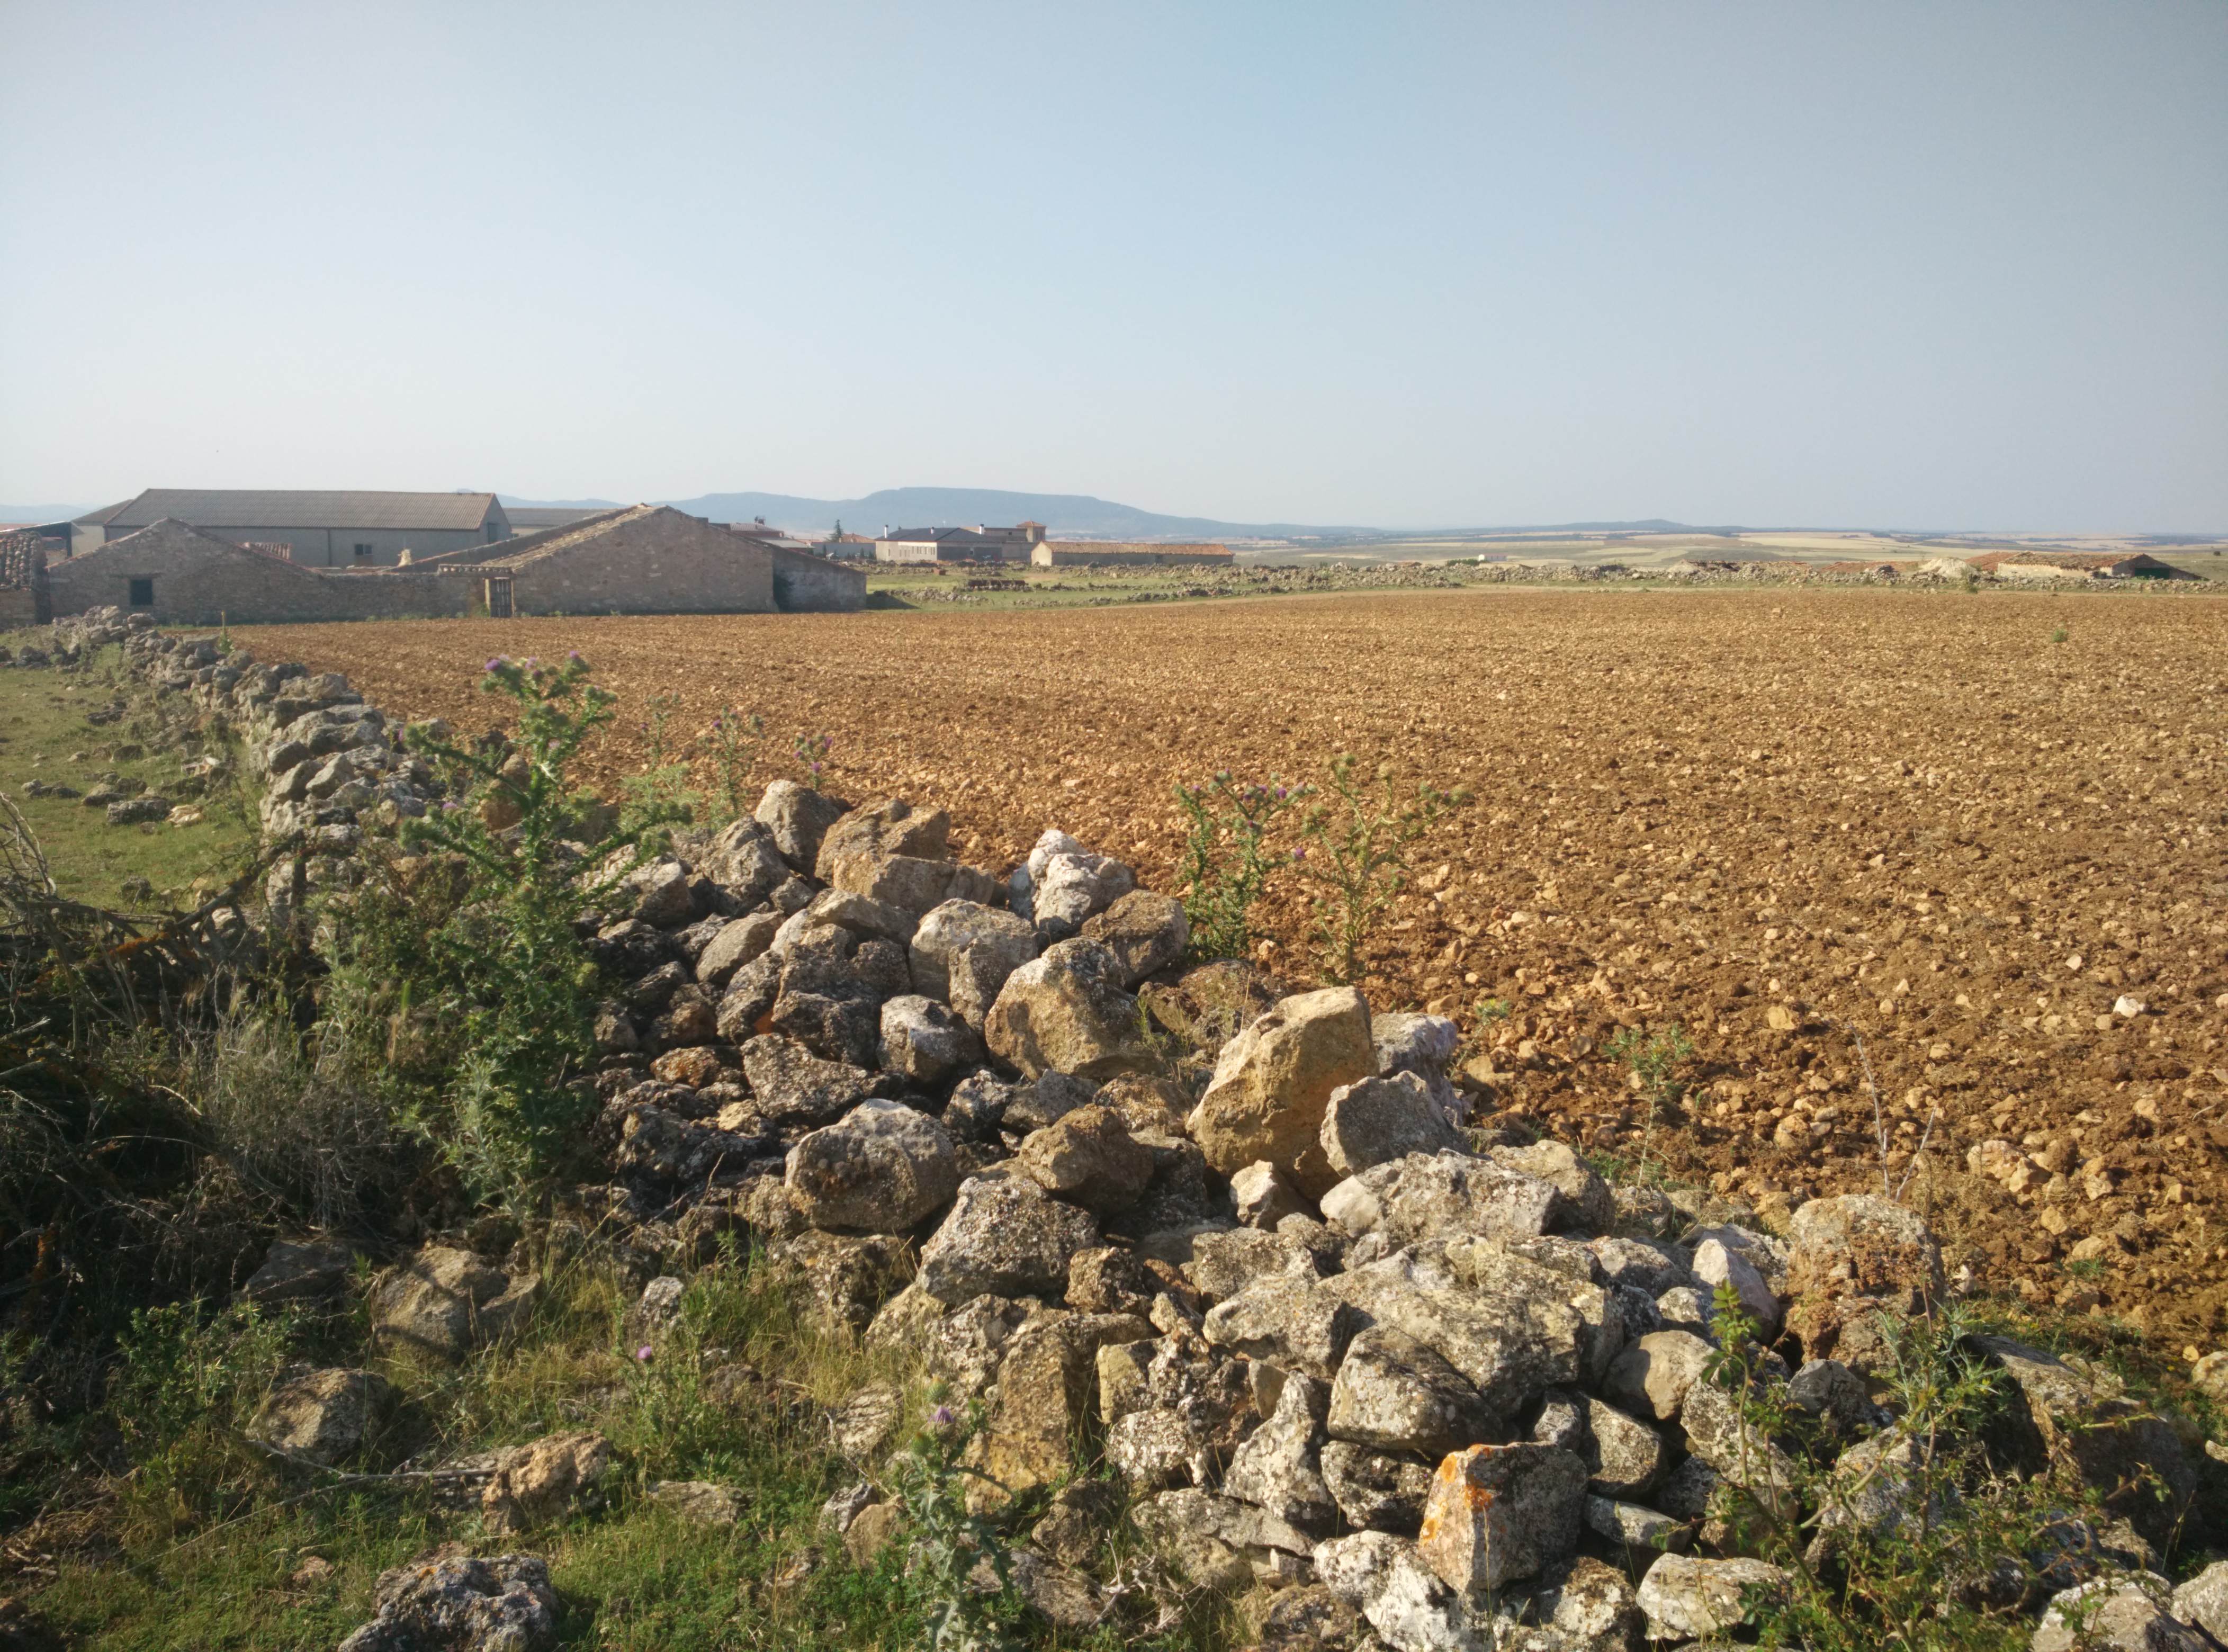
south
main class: Grassland
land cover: Grassland without tree/shrub cover
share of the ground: 50 - 75 %
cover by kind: herbaceous plants 55 %, unconsolidated bare surface 40 %, lichens and mosses 5 %
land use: Agriculture (excluding fallow land and kitchen gardens)
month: June
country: ES
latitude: 40.9767
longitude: -1.8002
